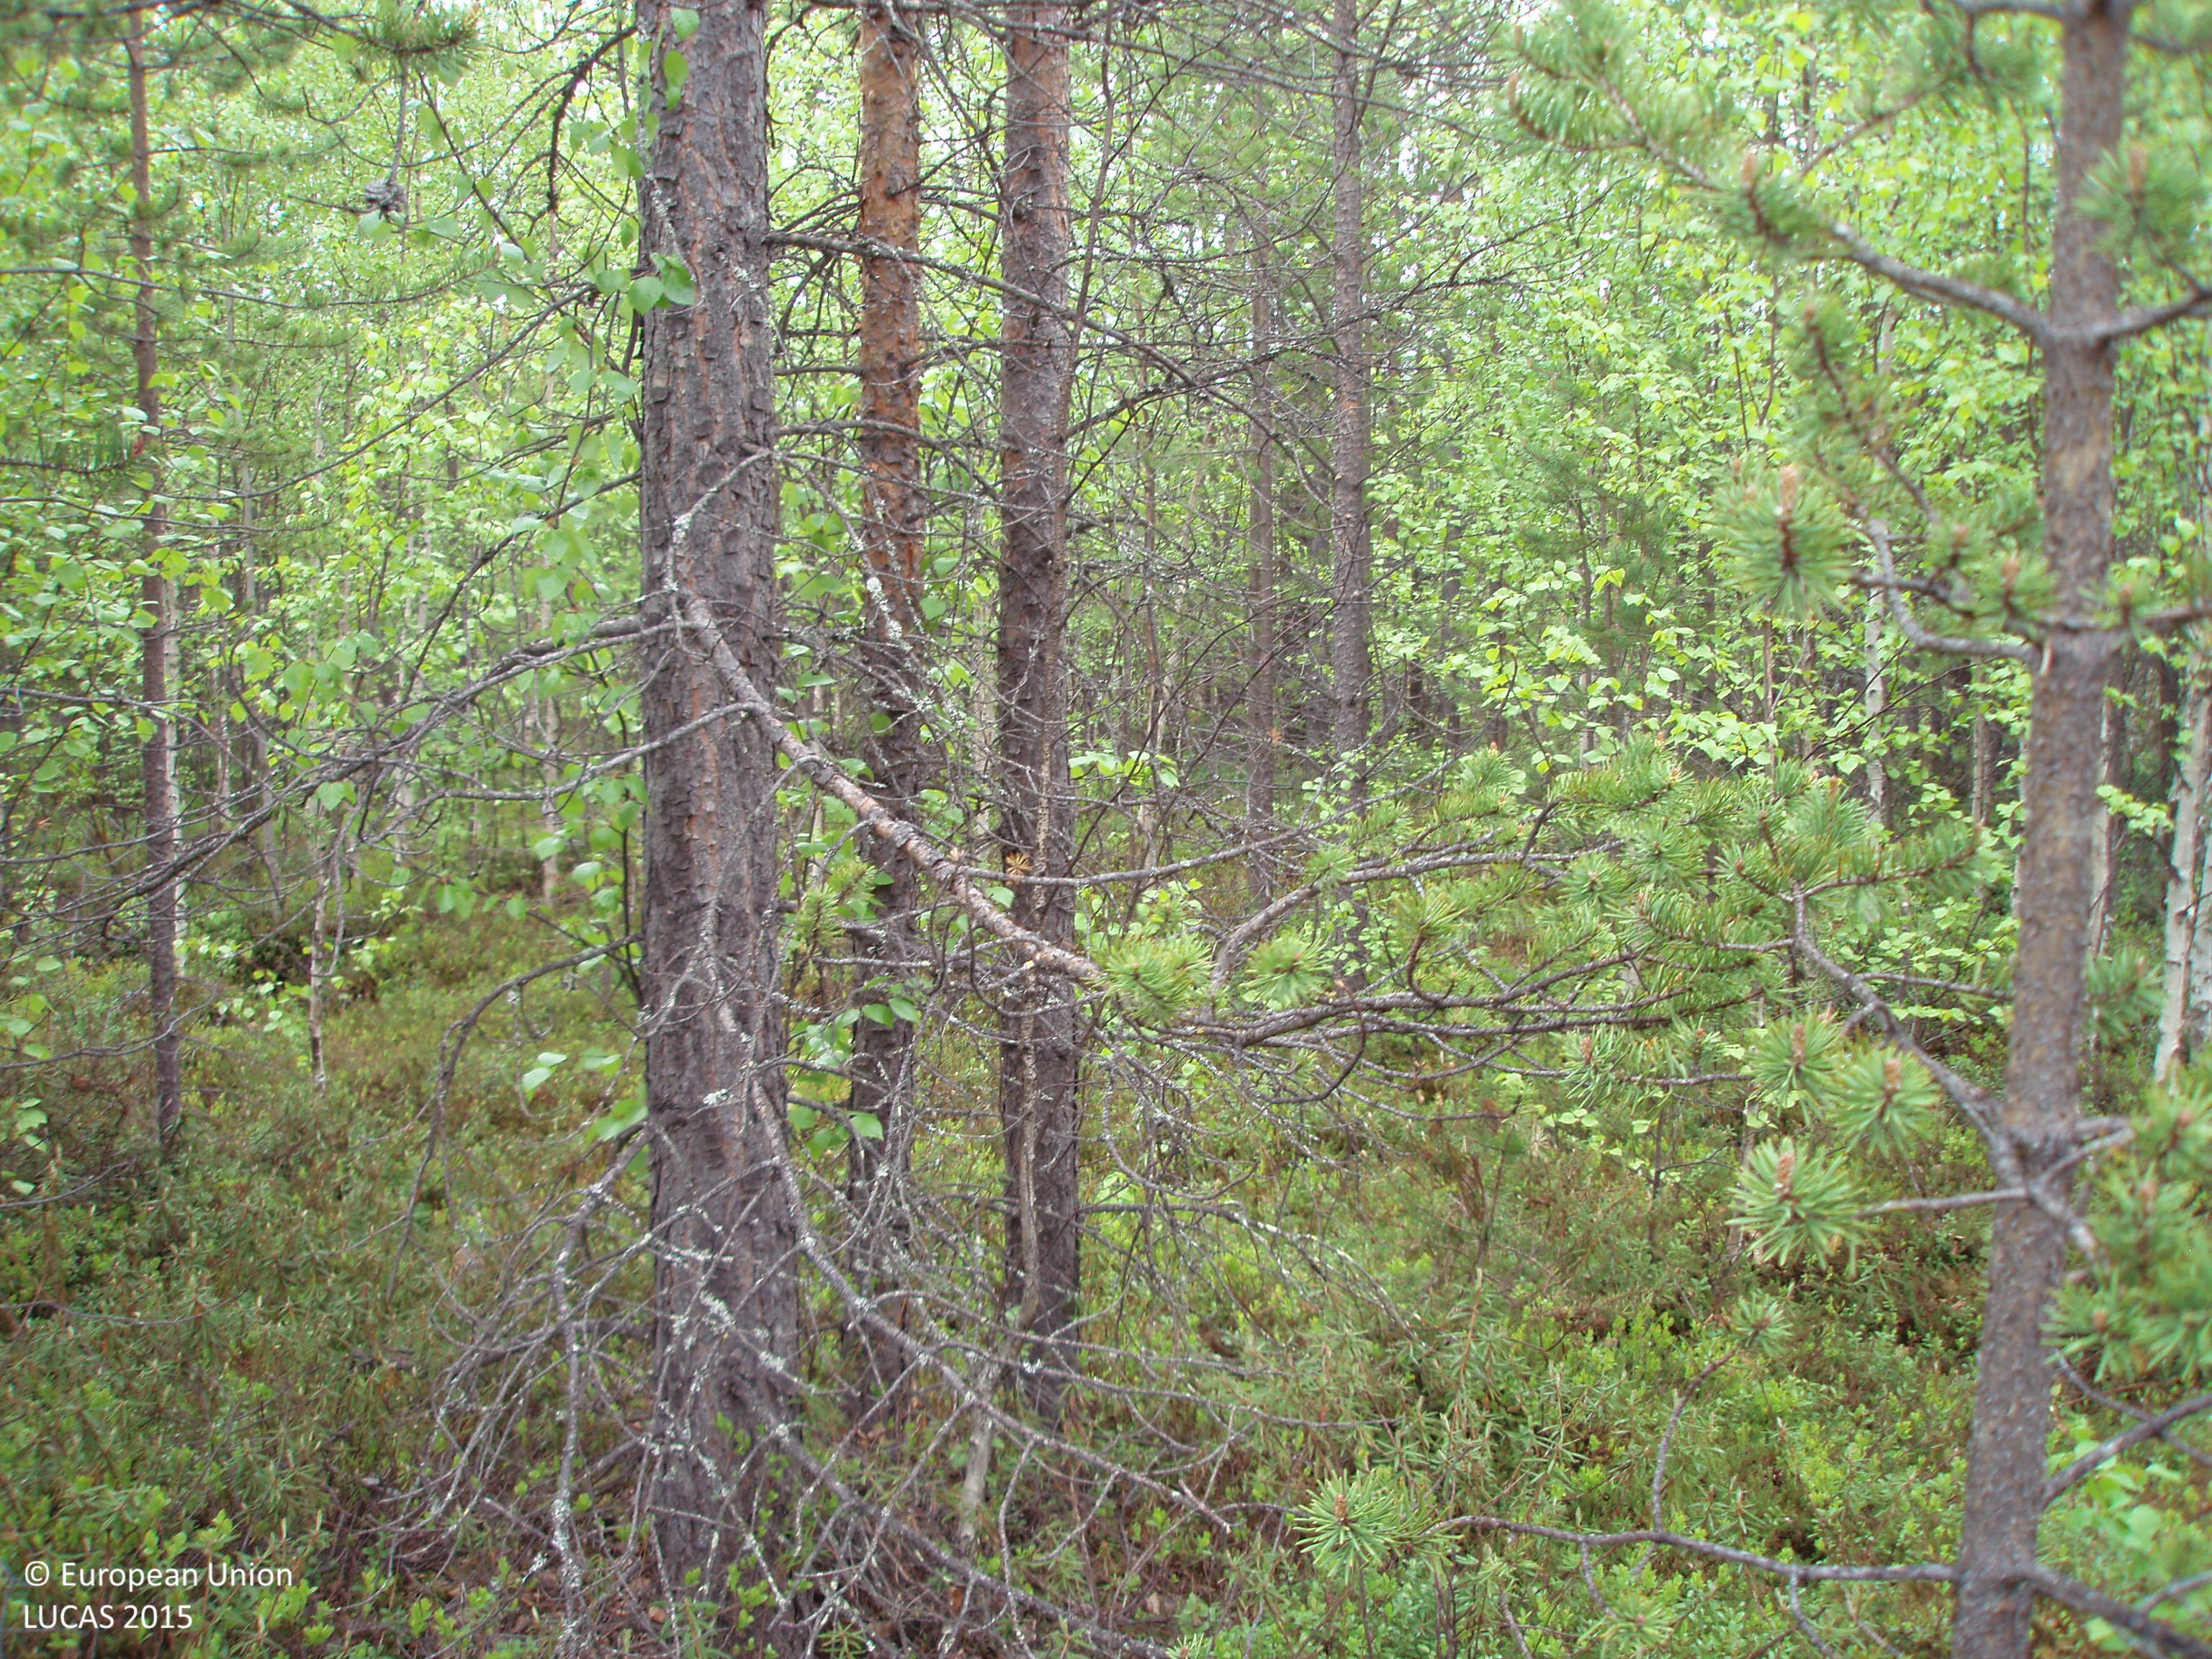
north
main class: Woodland
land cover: Pine dominated mixed woodland
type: boreal forest
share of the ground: > 75 %
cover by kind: broadleaved forest trees 70 %, coniferous forest trees 25 %, shrubs 5 %
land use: Forestry
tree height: > 5 m
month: June
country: FI
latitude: 67.3903
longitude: 26.6972
